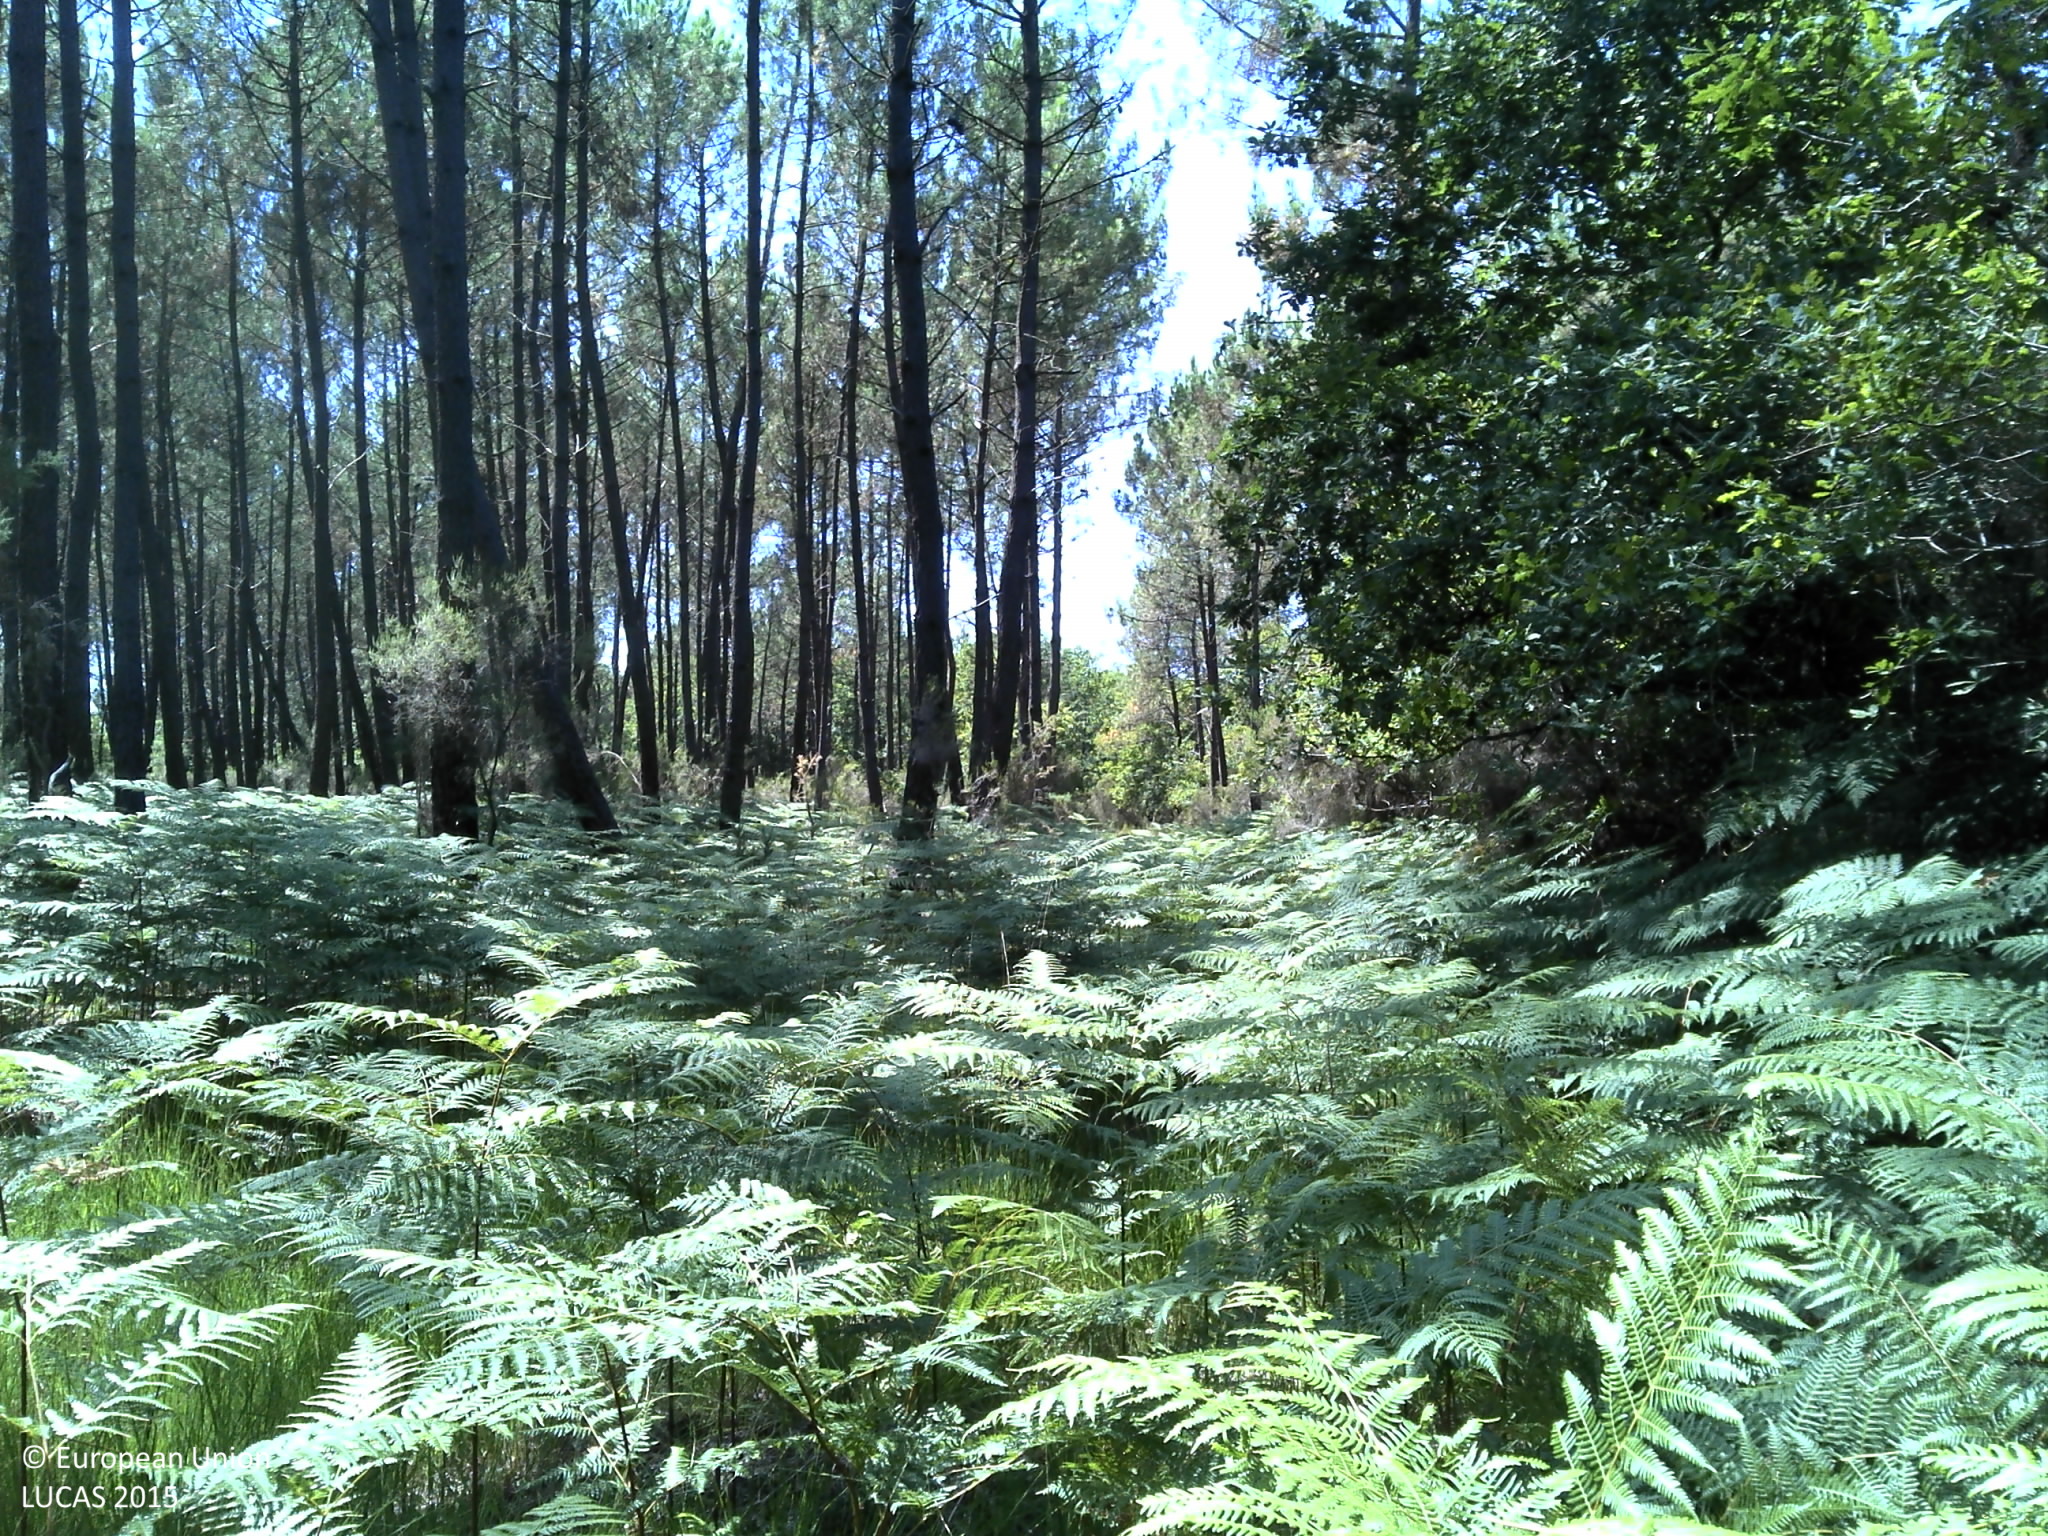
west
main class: Woodland
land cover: Pine dominated coniferous woodland
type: coniferous forest of the mediterranean region
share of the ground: > 75 %
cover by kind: shrubs 45 %, coniferous forest trees 40 %, herbaceous plants 10 %, broadleaved forest trees 5 %
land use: Forestry
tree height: > 5 m
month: August
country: FR
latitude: 45.1788
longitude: -1.0327
